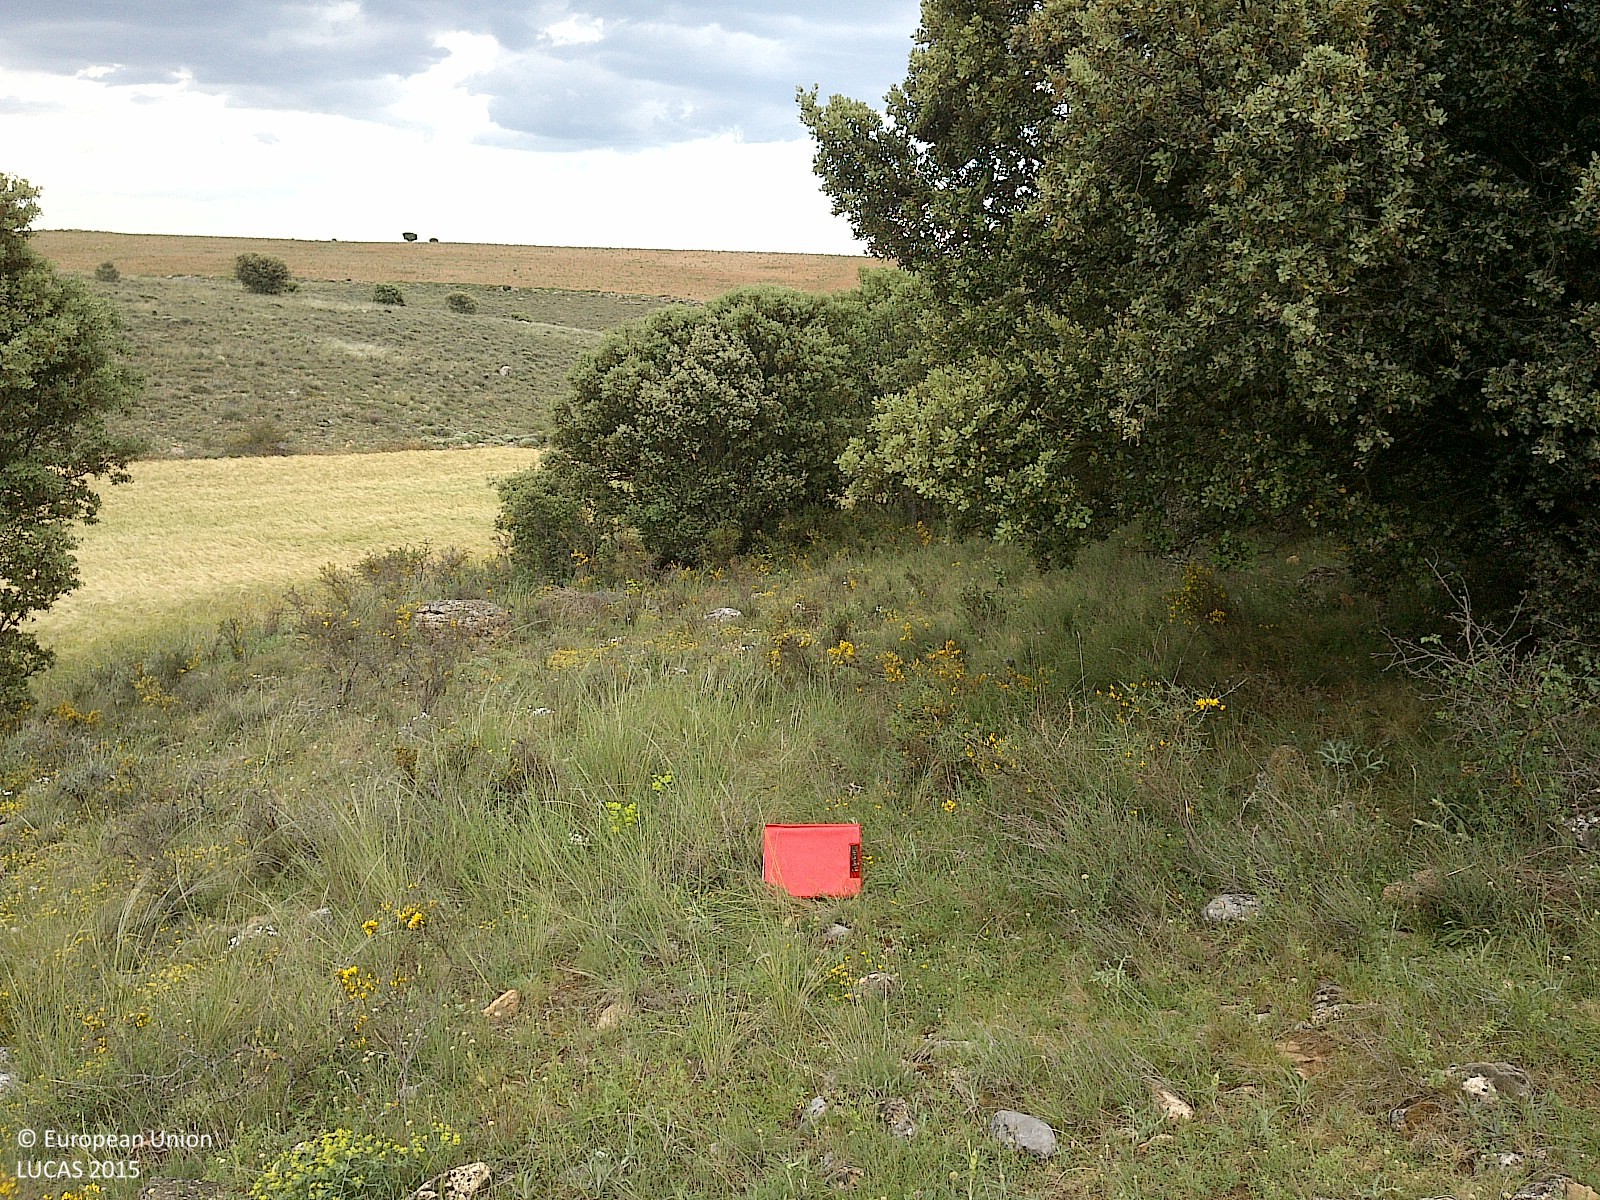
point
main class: Woodland
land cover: Broadleaved woodland
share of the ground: 25 - 50 %
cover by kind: herbaceous plants 50 %, broadleaved forest trees 40 %, shrubs 10 %
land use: Semi-natural and natural areas not in use
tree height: < 5 m
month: June
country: ES
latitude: 41.7236
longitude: -2.2605
